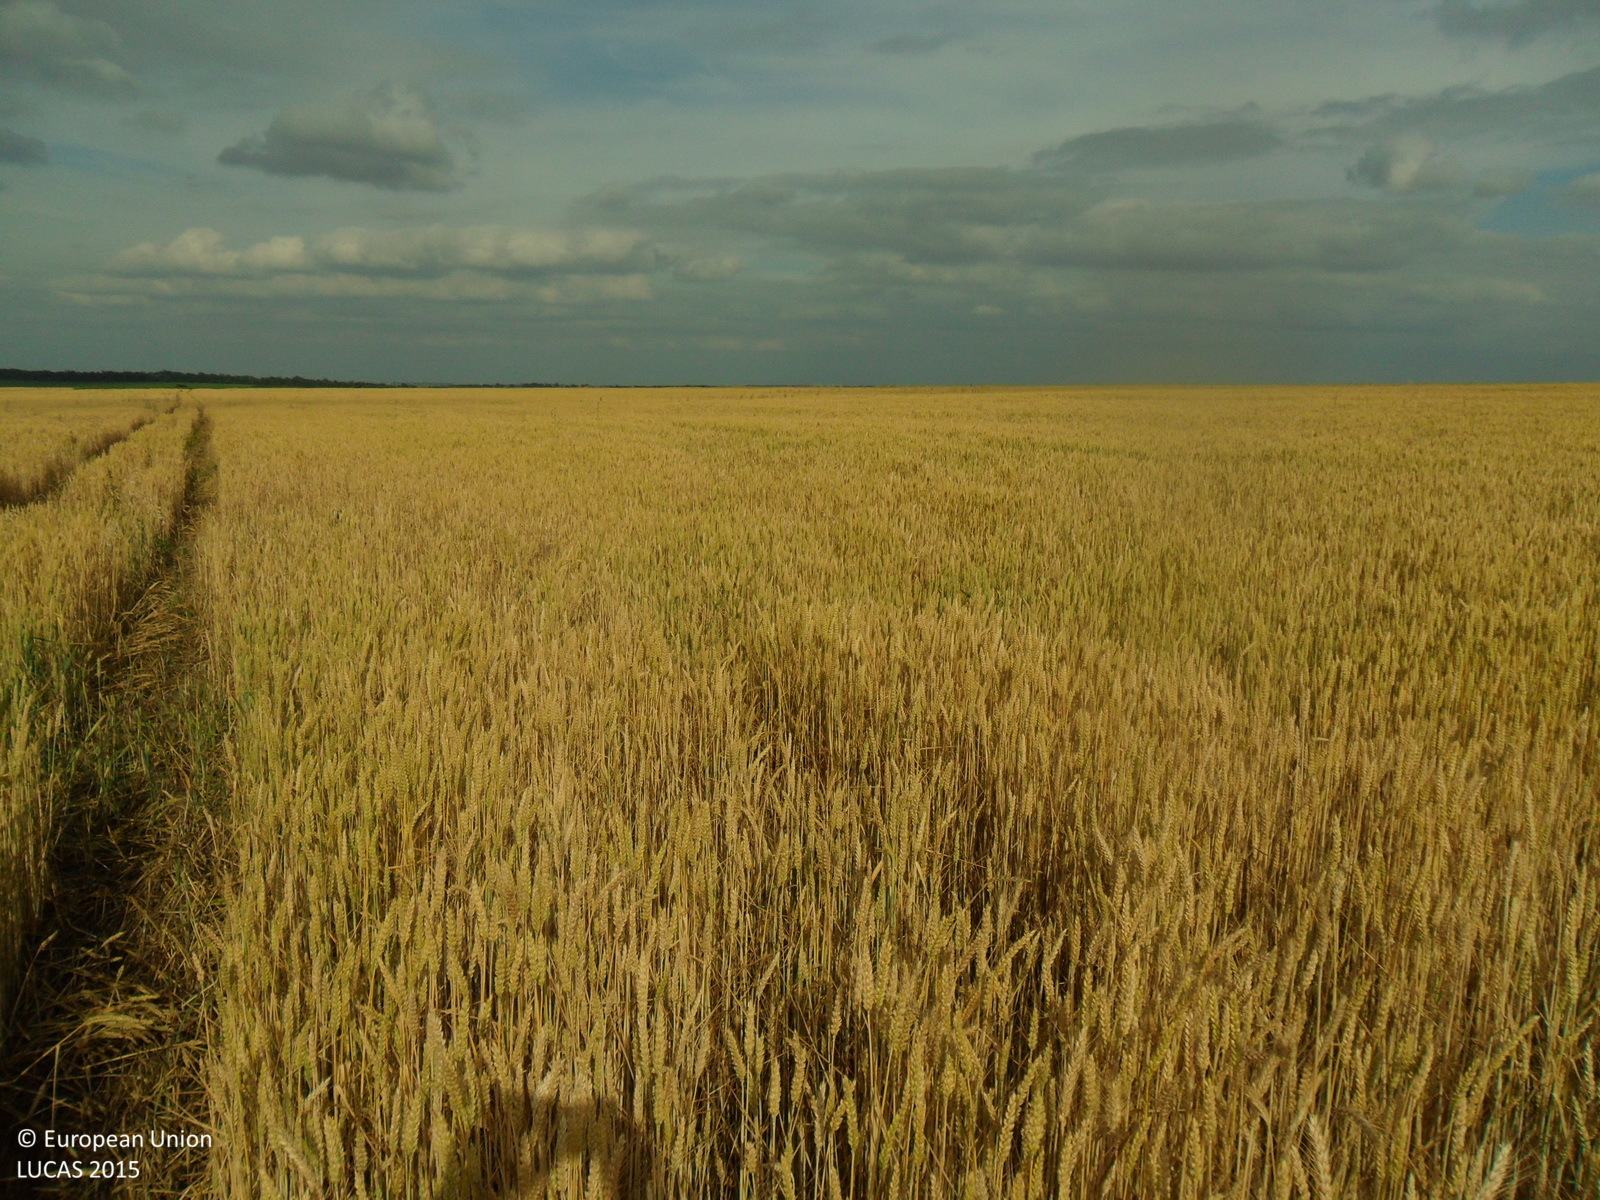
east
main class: Cropland
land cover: Common wheat
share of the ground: > 75 %
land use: Agriculture (excluding fallow land and kitchen gardens)
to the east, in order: Common wheat
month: June
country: BG
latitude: 43.7914
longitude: 26.8313
